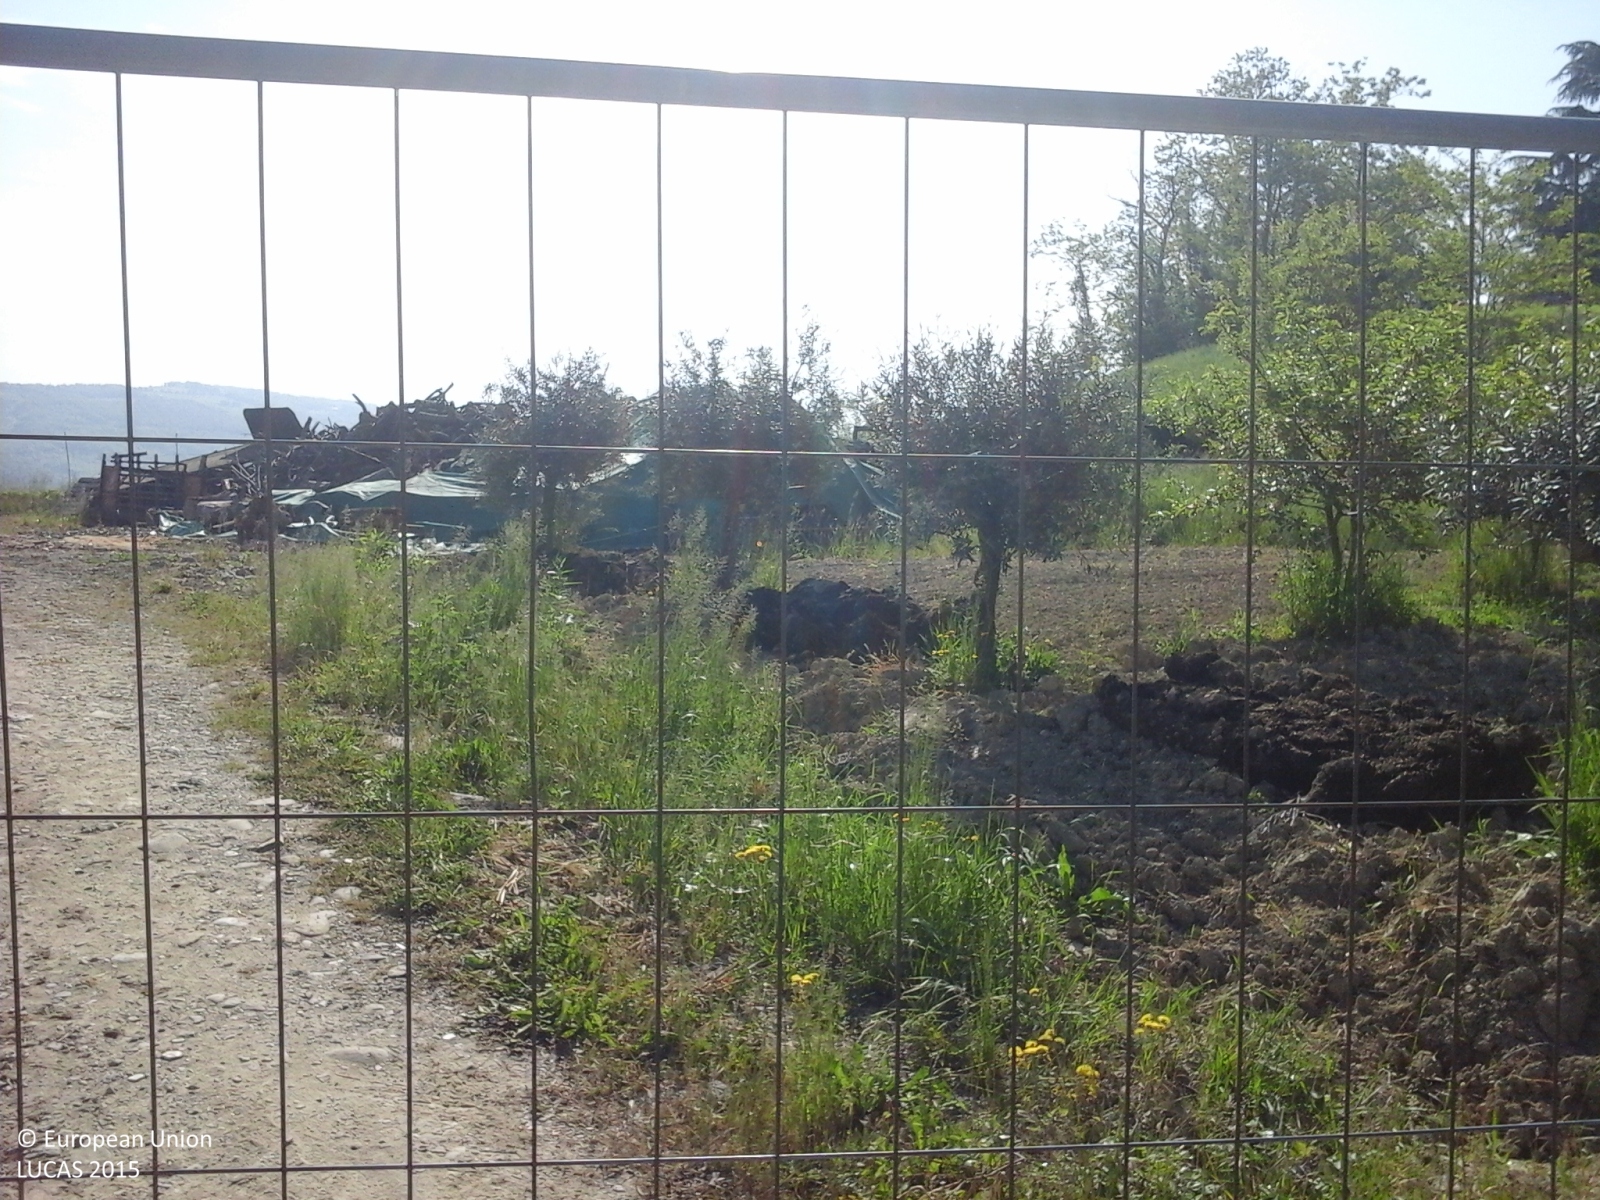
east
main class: Woodland
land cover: Broadleaved woodland
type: thermophilous deciduous forest
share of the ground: > 75 %
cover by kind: broadleaved forest trees 100 %
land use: Forestry
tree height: > 5 m
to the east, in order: Broadleaved woodland; Grassland without tree/shrub cover; Broadleaved woodland; Inland fresh running water; Broadleaved woodland; Paved roads, cycling and walking lanes; Fences; Electric lines; Grassland without tree/shrub cover; Electric lines; Lucerne
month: May
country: IT
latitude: 44.4002
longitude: 10.9646
